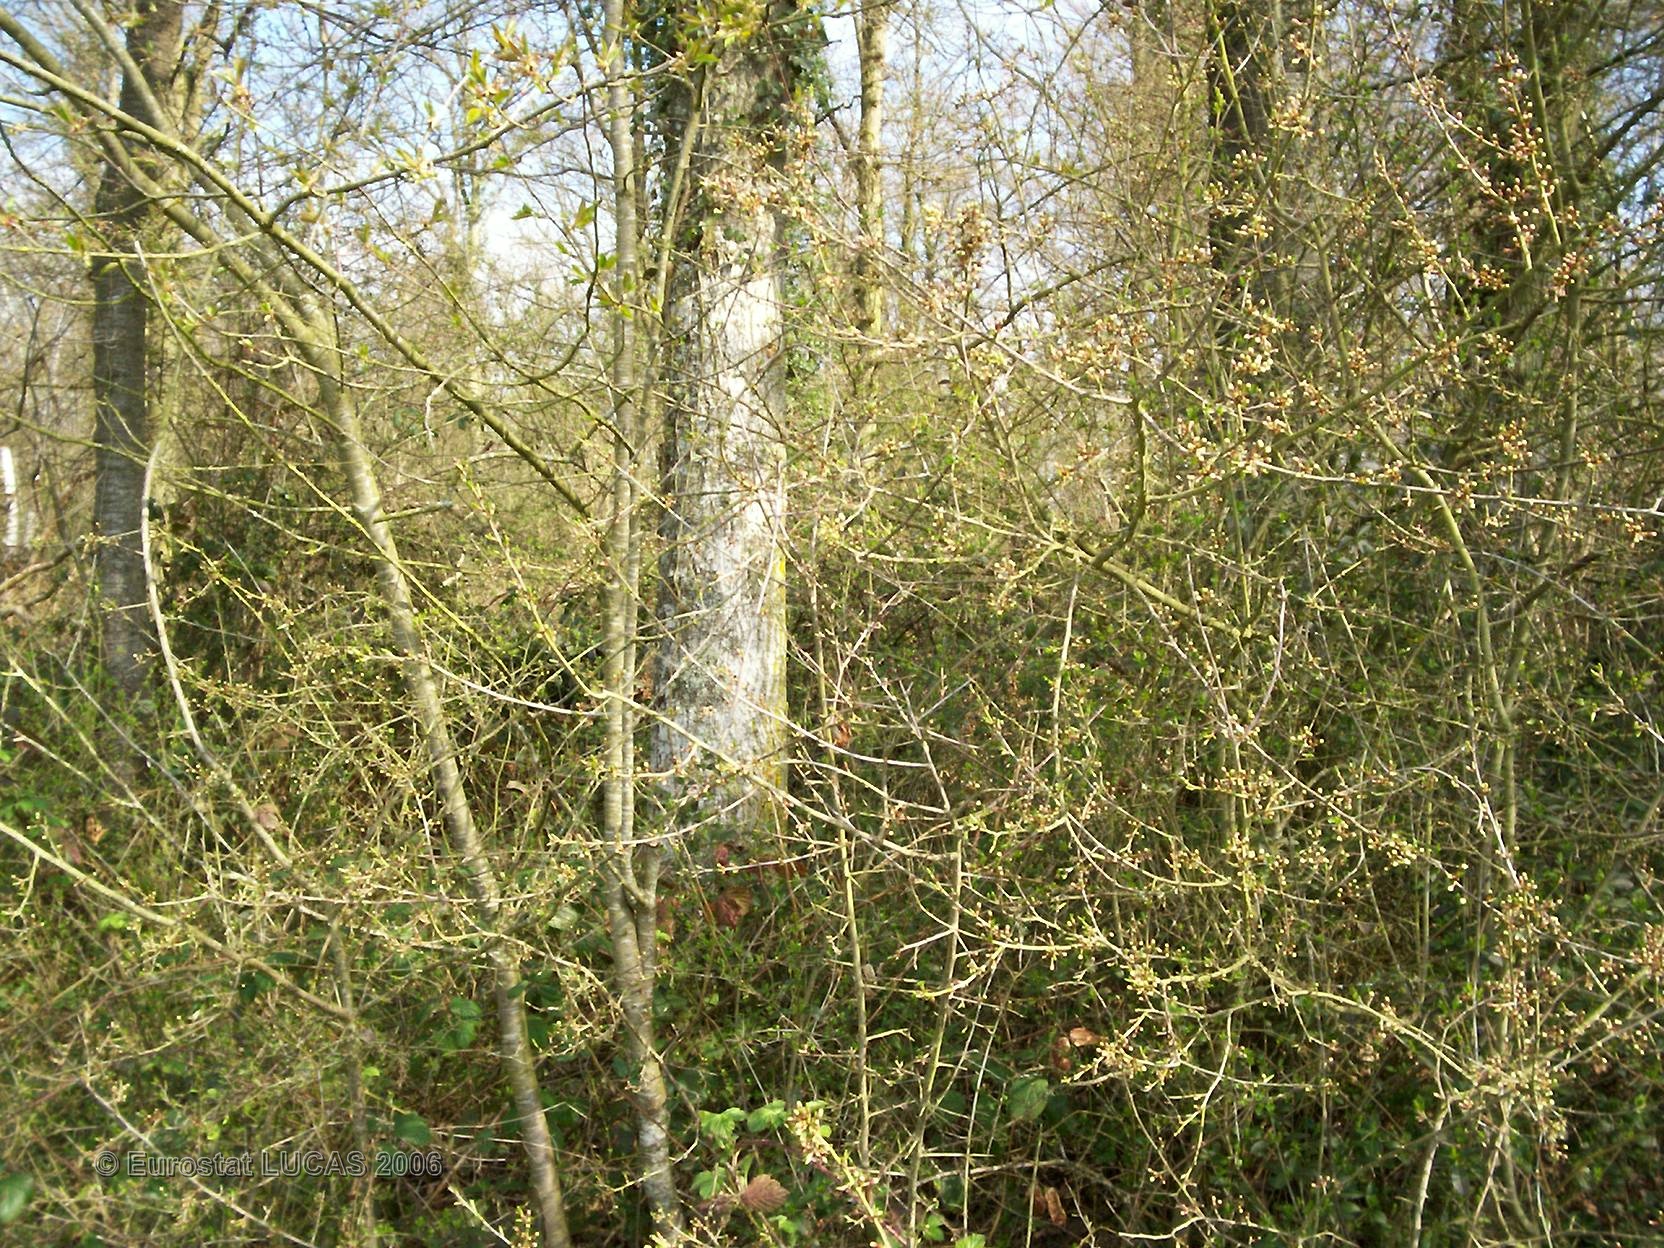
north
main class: Grassland
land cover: Grassland without tree/shrub cover
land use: Agriculture (excluding fallow land and kitchen gardens)
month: April
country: FR
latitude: 49.0174
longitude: 1.0499
